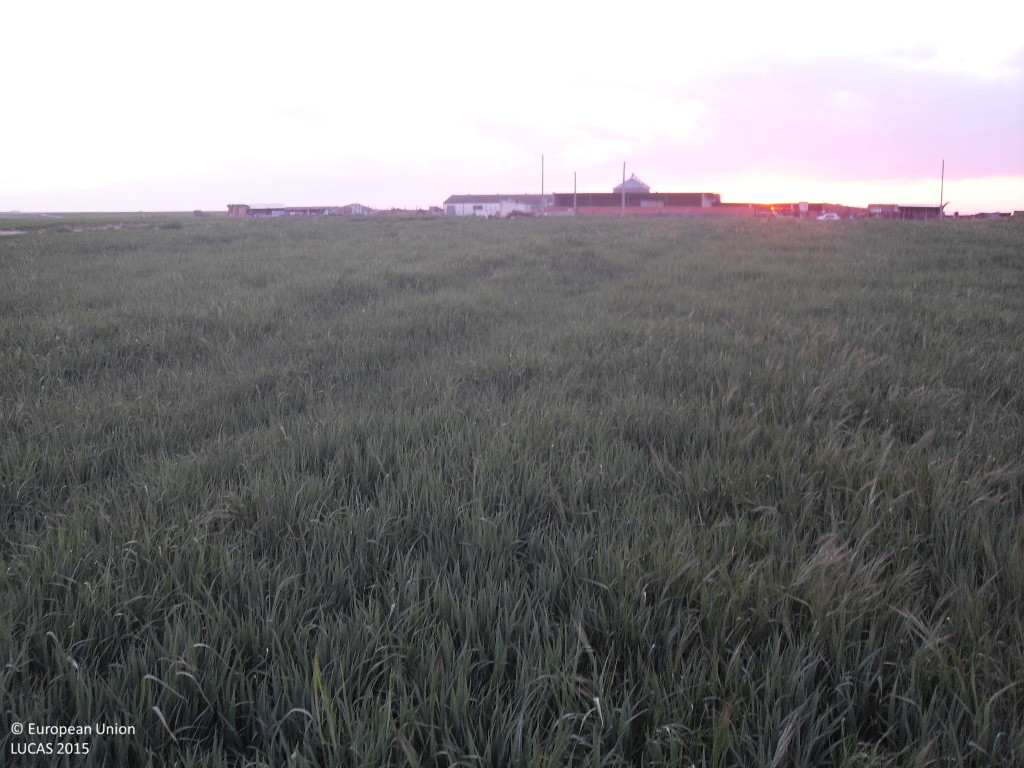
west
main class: Cropland
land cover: Oats
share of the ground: > 75 %
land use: Agriculture (excluding fallow land and kitchen gardens)
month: April
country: ES
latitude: 40.8544
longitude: -5.2155
